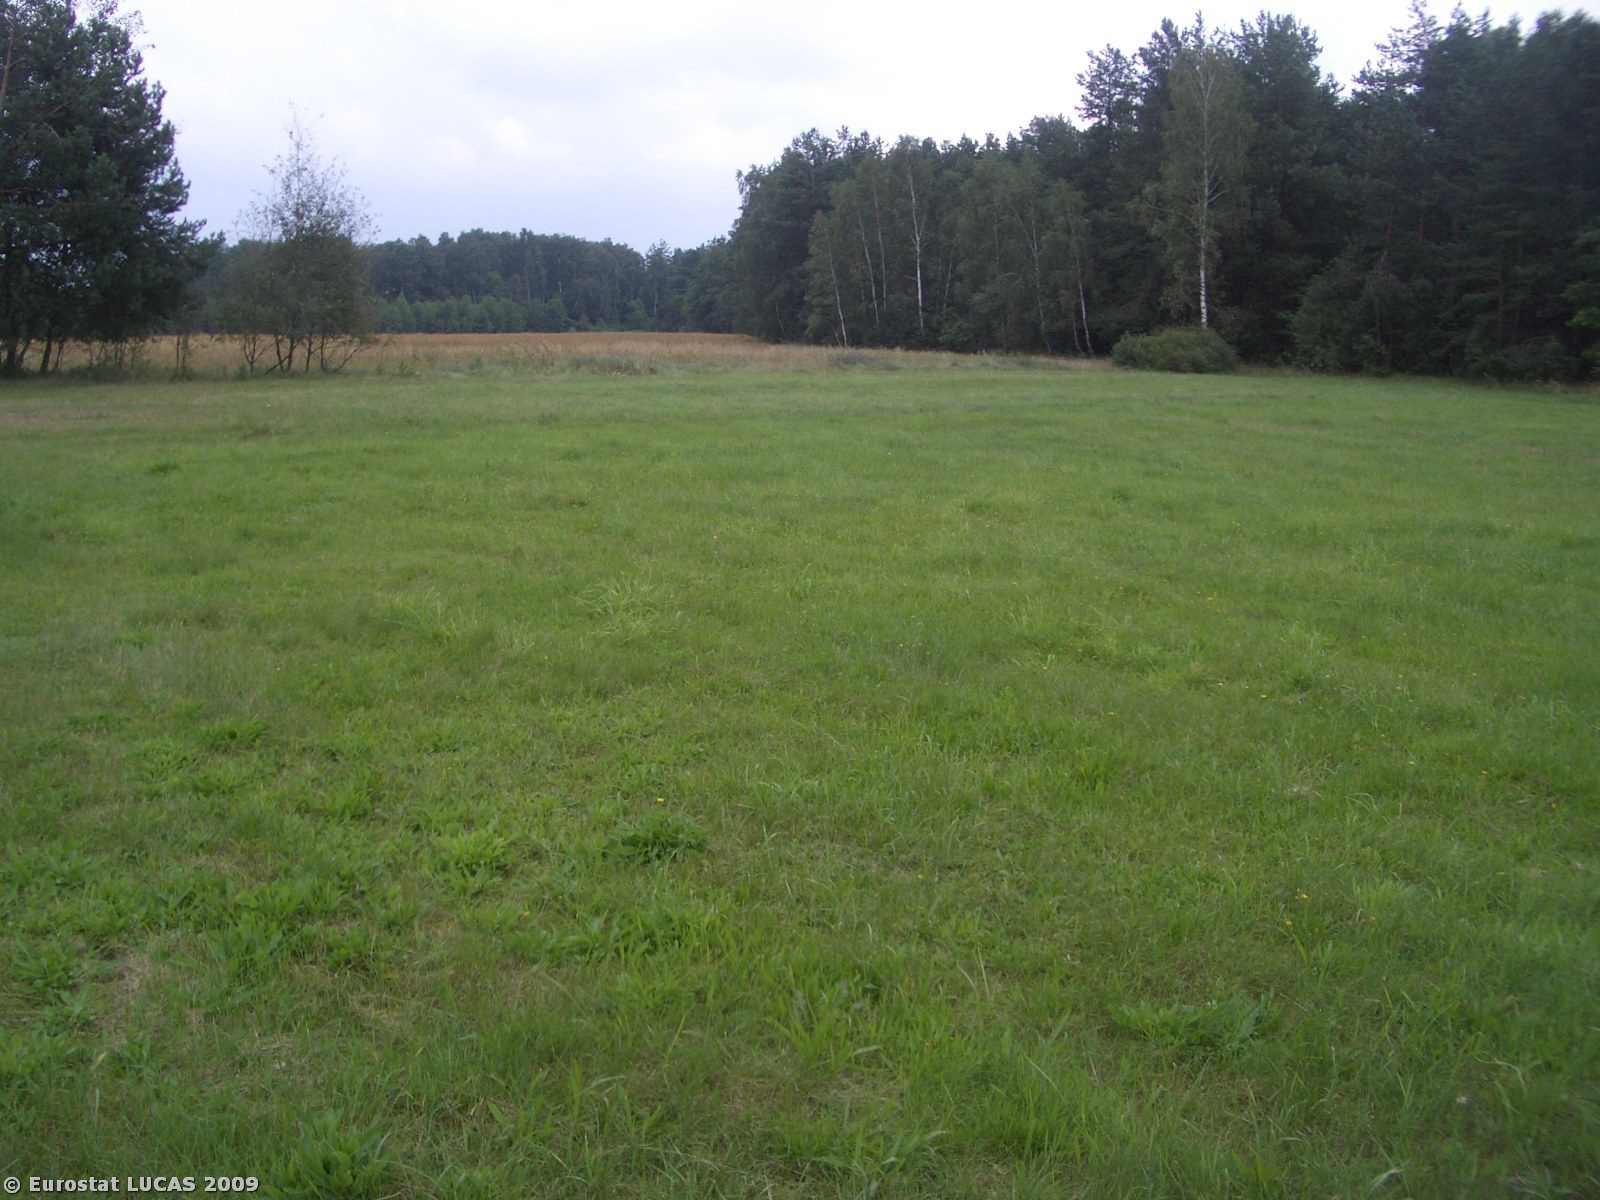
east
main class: Grassland
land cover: Grassland without tree/shrub cover
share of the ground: > 75 %
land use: Agriculture (excluding fallow land and kitchen gardens)
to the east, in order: Grassland without tree/shrub cover; Bare land; Oats; Fences; Mixed woodland
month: August
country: PL
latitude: 51.9234
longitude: 23.2391
